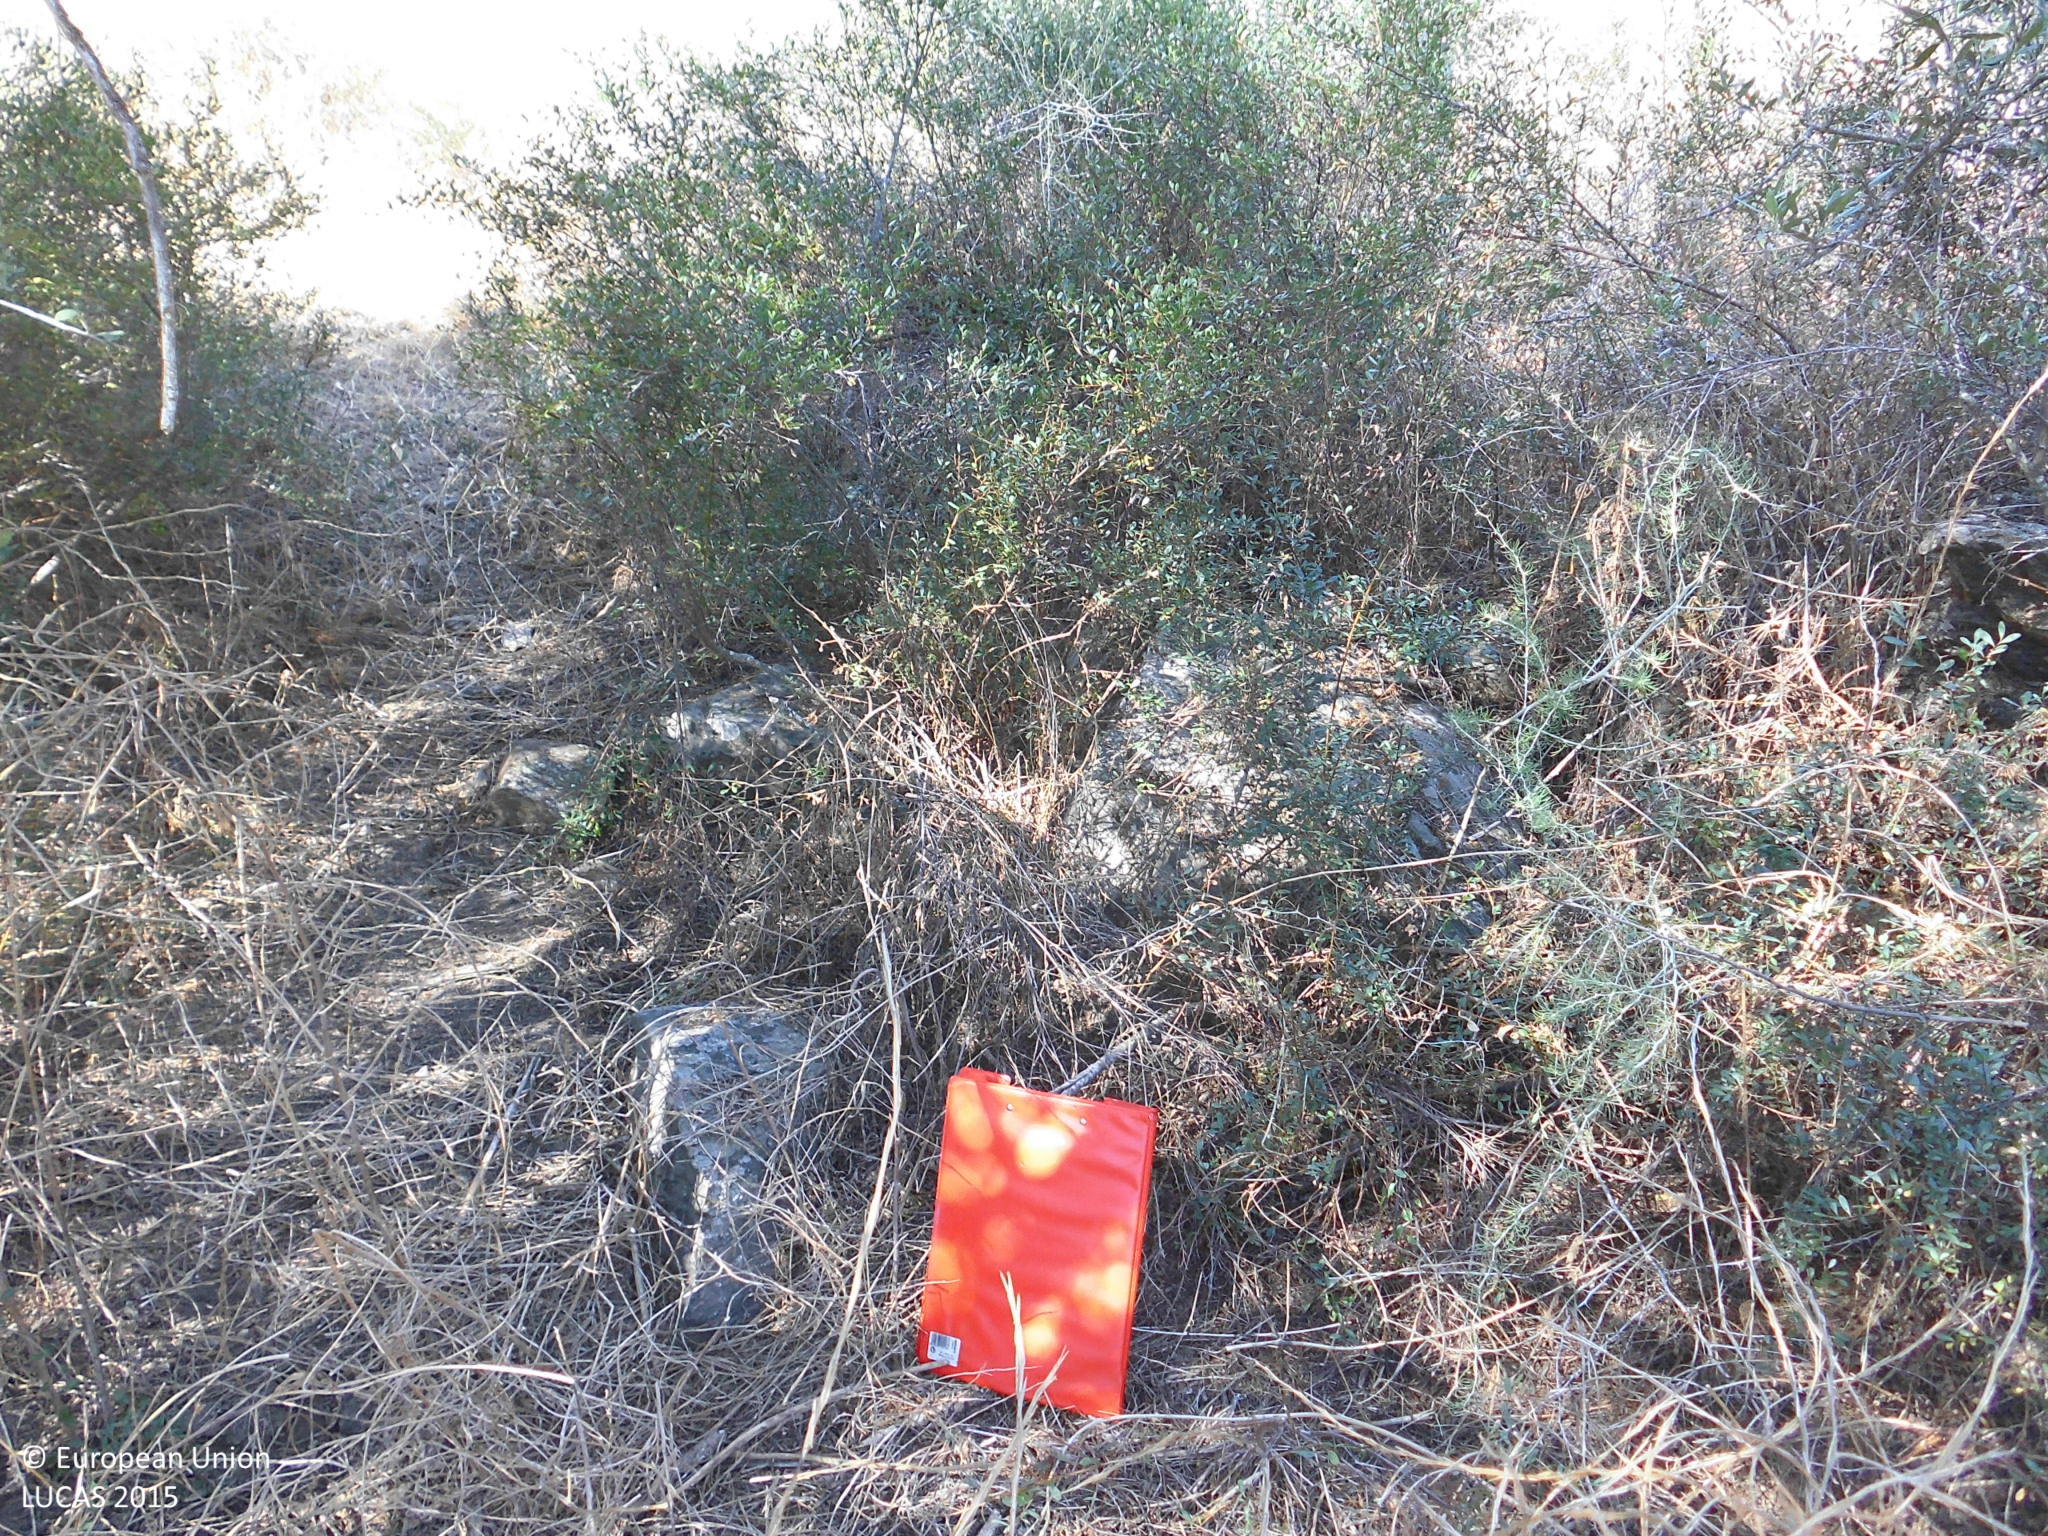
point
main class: Woodland
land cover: Broadleaved woodland
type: thermophilous deciduous forest
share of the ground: 25 - 50 %
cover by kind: broadleaved forest trees 50 %, shrubs 40 %, herbaceous plants 10 %
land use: Semi-natural and natural areas not in use
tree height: > 5 m
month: June
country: ES
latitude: 39.7347
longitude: -6.4444
